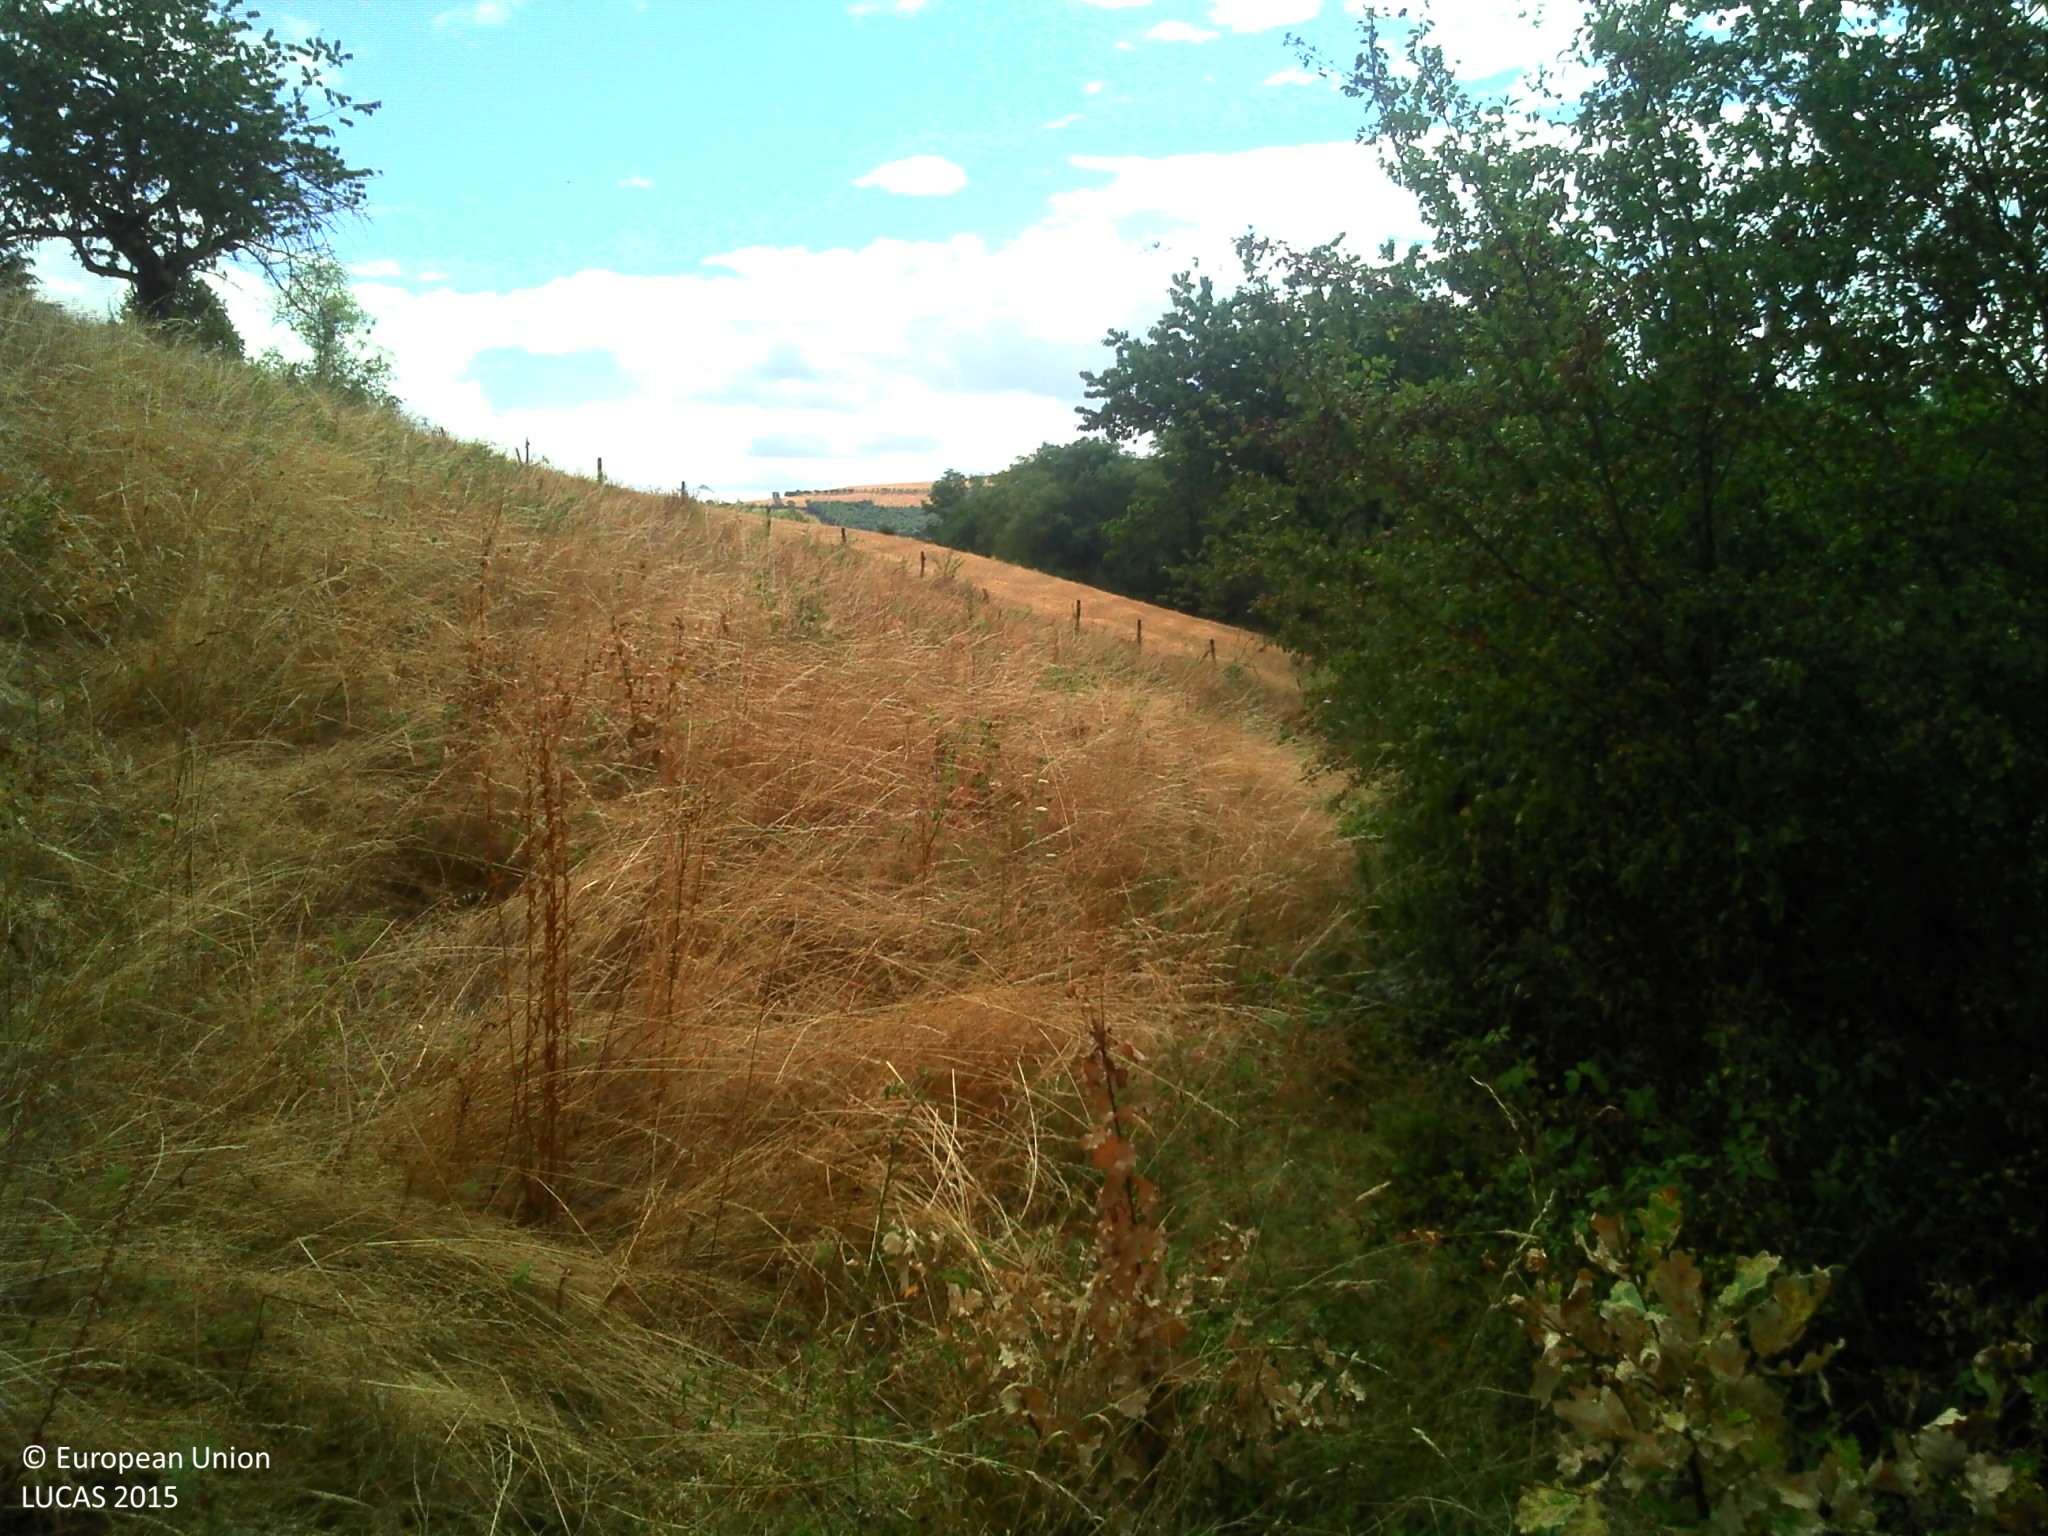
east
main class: Grassland
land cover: Spontaneously vegetated surfaces
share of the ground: > 75 %
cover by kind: herbaceous plants 80 %, lichens and mosses 15 %, shrubs 5 %
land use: Semi-natural and natural areas not in use
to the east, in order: Spontaneously vegetated surfaces; Grassland with sparse tree/shrub cover; Spontaneously vegetated surfaces; Broadleaved woodland; Spontaneously vegetated surfaces; Tracks; Spontaneously vegetated surfaces; Broadleaved woodland; Spontaneously vegetated surfaces
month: July
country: FR
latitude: 45.7796
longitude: 4.5628
